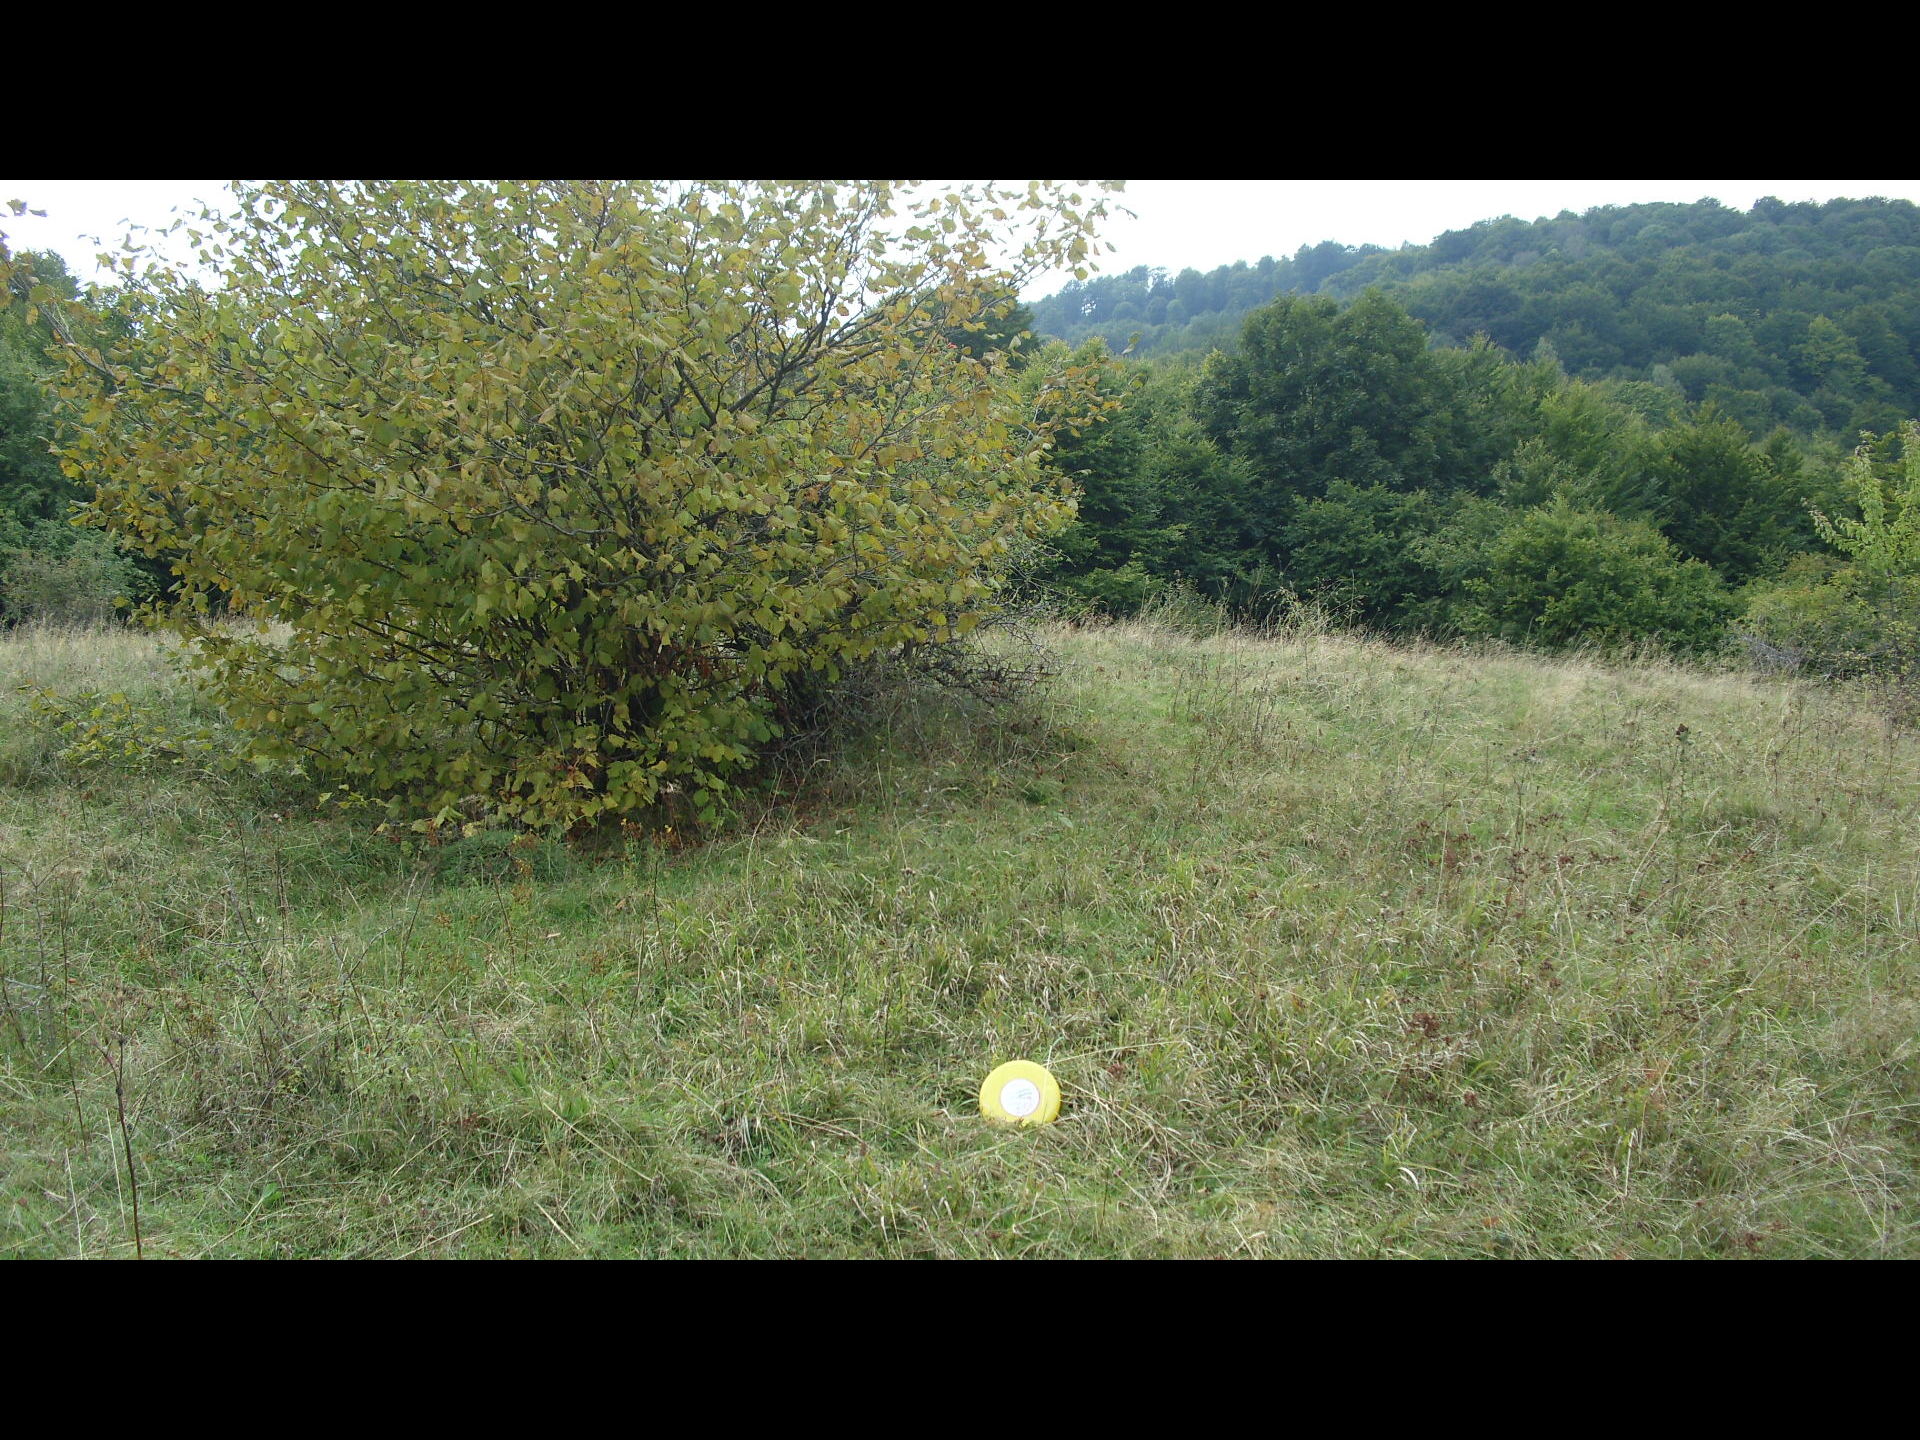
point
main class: Grassland
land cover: Grassland with sparse tree/shrub cover
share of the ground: > 75 %
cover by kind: herbaceous plants 90 %, broadleaved forest trees 5 %, shrubs 5 %
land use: Agriculture (excluding fallow land and kitchen gardens)
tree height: < 5 m
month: October
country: BG
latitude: 43.3470
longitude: 22.8512
